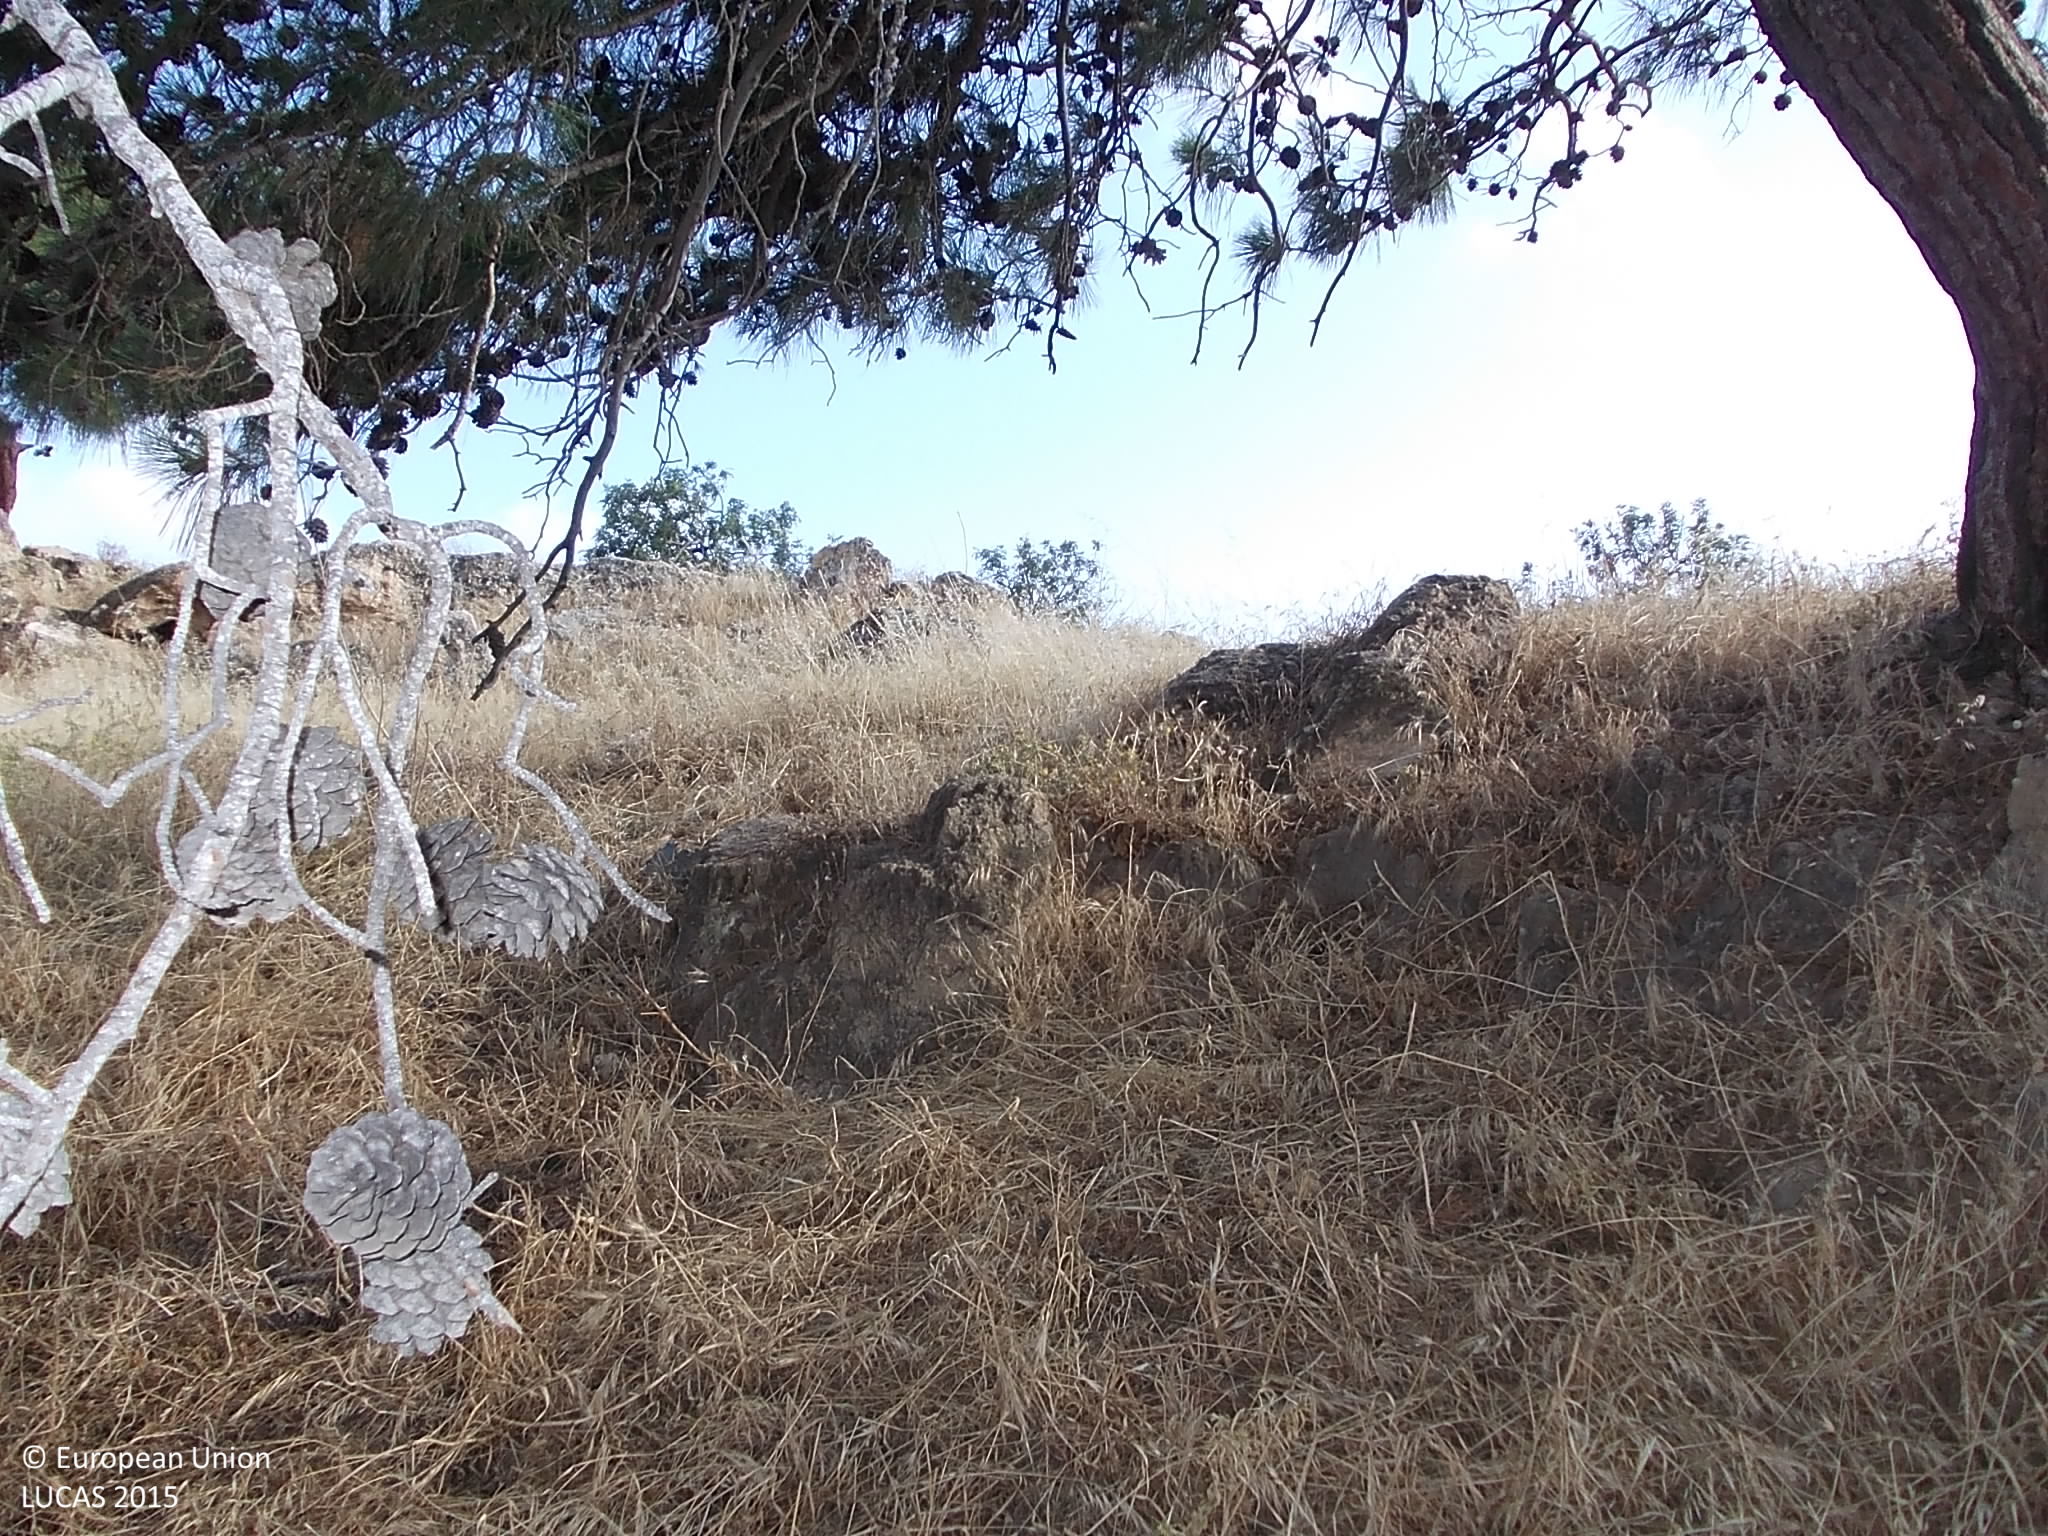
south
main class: Woodland
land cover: Pine dominated coniferous woodland
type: coniferous forest of the mediterranean region
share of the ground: 25 - 50 %
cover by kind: herbaceous plants 50 %, coniferous forest trees 35 %, consolidated bare surface 15 %
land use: Semi-natural and natural areas not in use
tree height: > 5 m
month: June
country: CY
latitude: 34.6676
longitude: 32.6857
